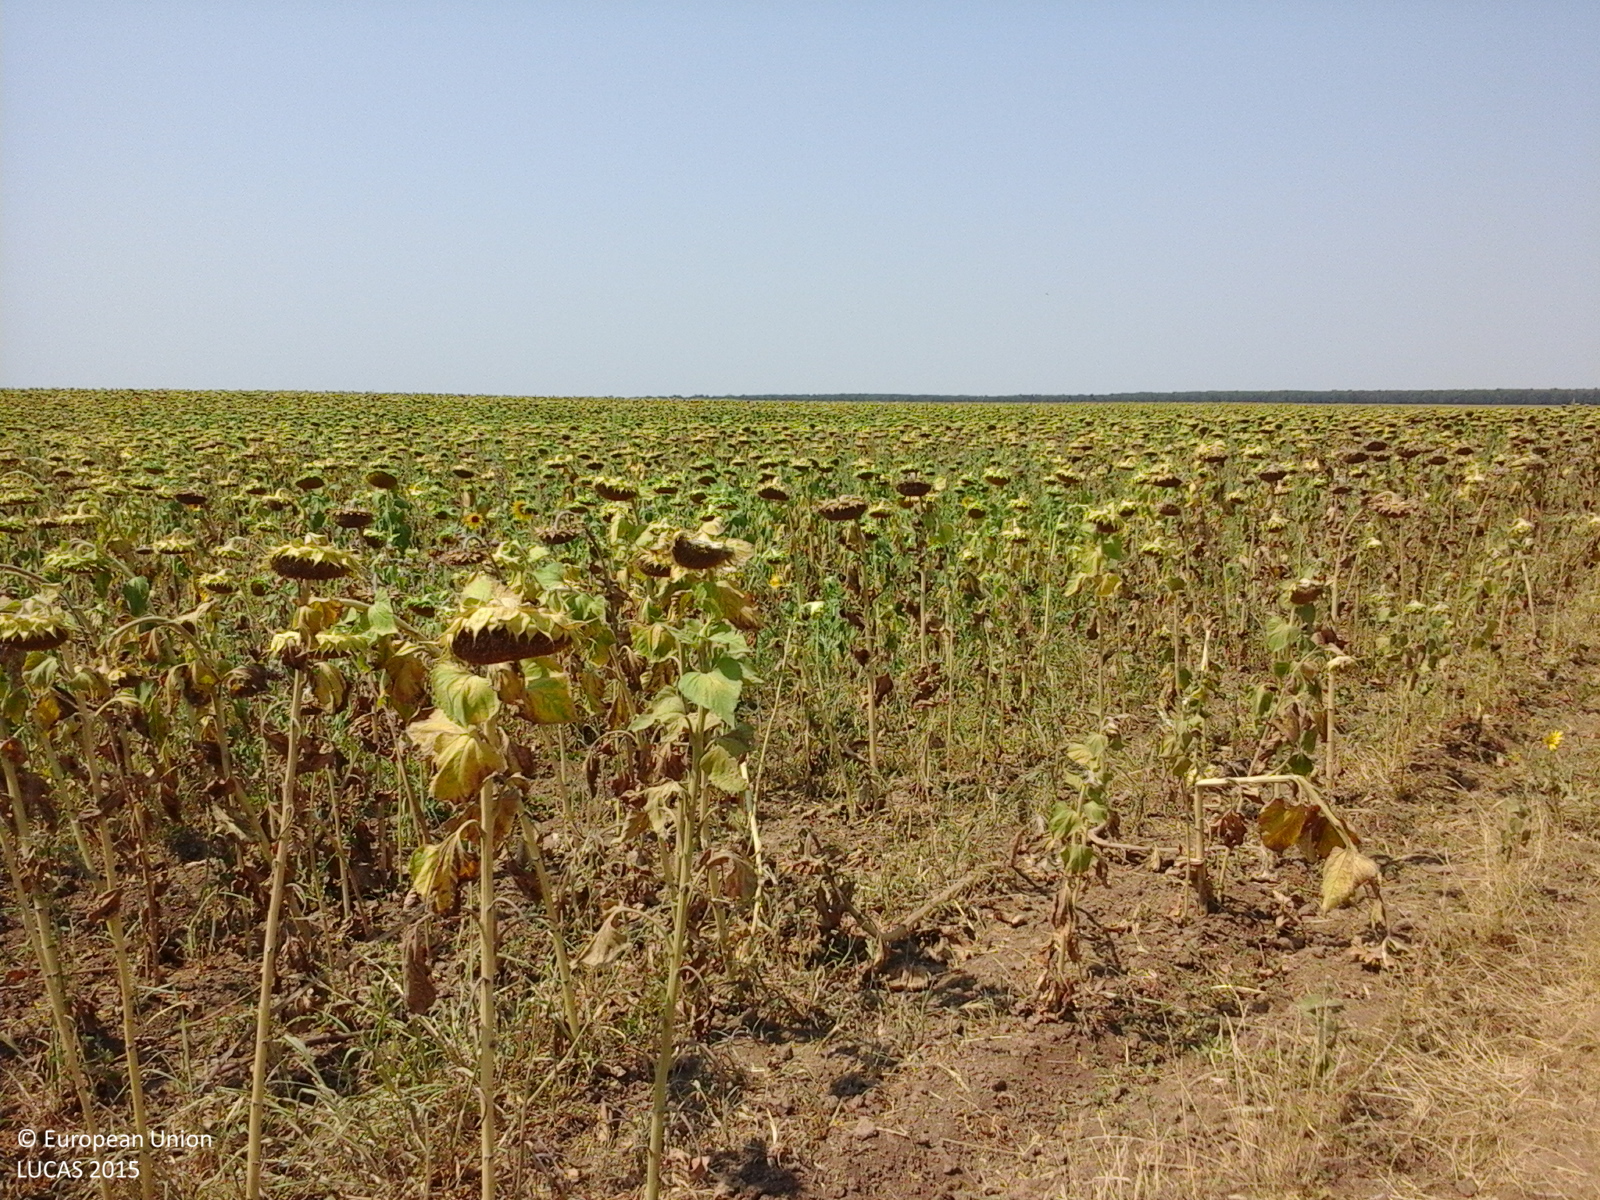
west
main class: Cropland
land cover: Sunflower
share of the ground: > 75 %
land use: Agriculture (excluding fallow land and kitchen gardens)
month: August
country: RO
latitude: 44.2650
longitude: 23.2379
